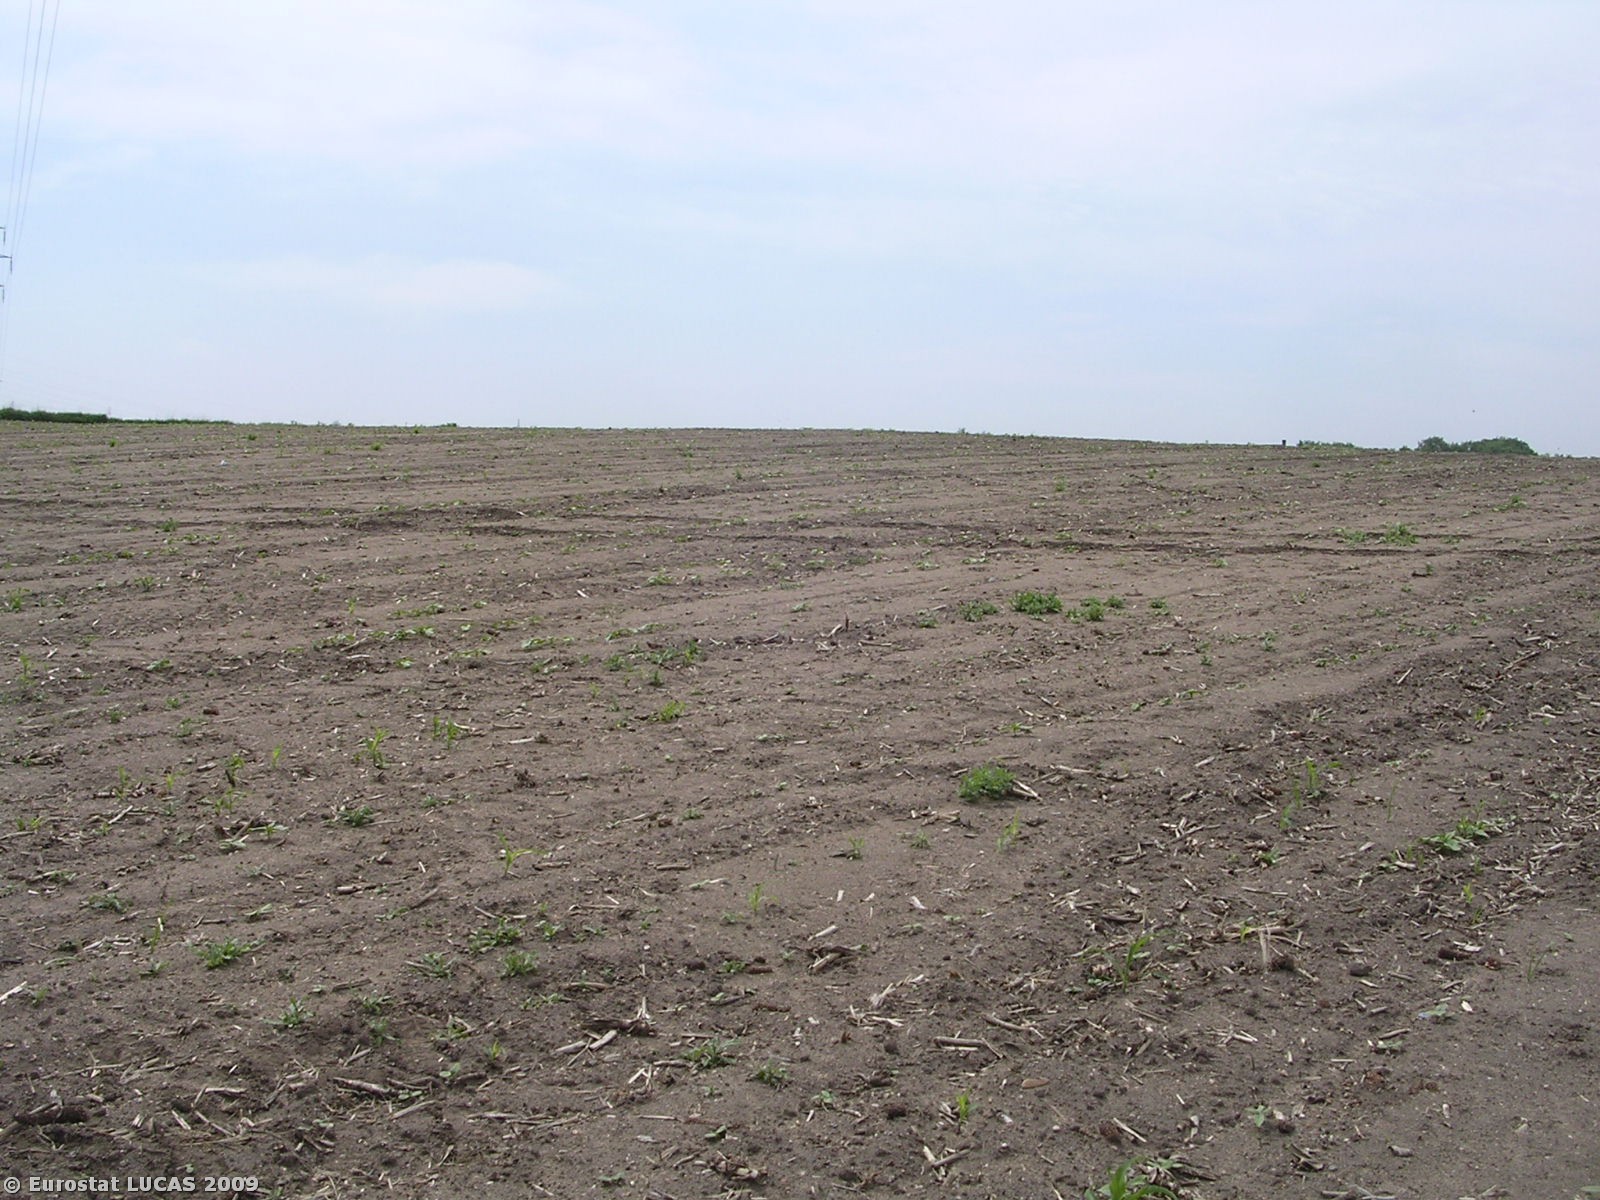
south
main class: Cropland
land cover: Sunflower
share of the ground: < 10 %
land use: Agriculture (excluding fallow land and kitchen gardens)
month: May
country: CZ
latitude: 50.3112
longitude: 14.5093
